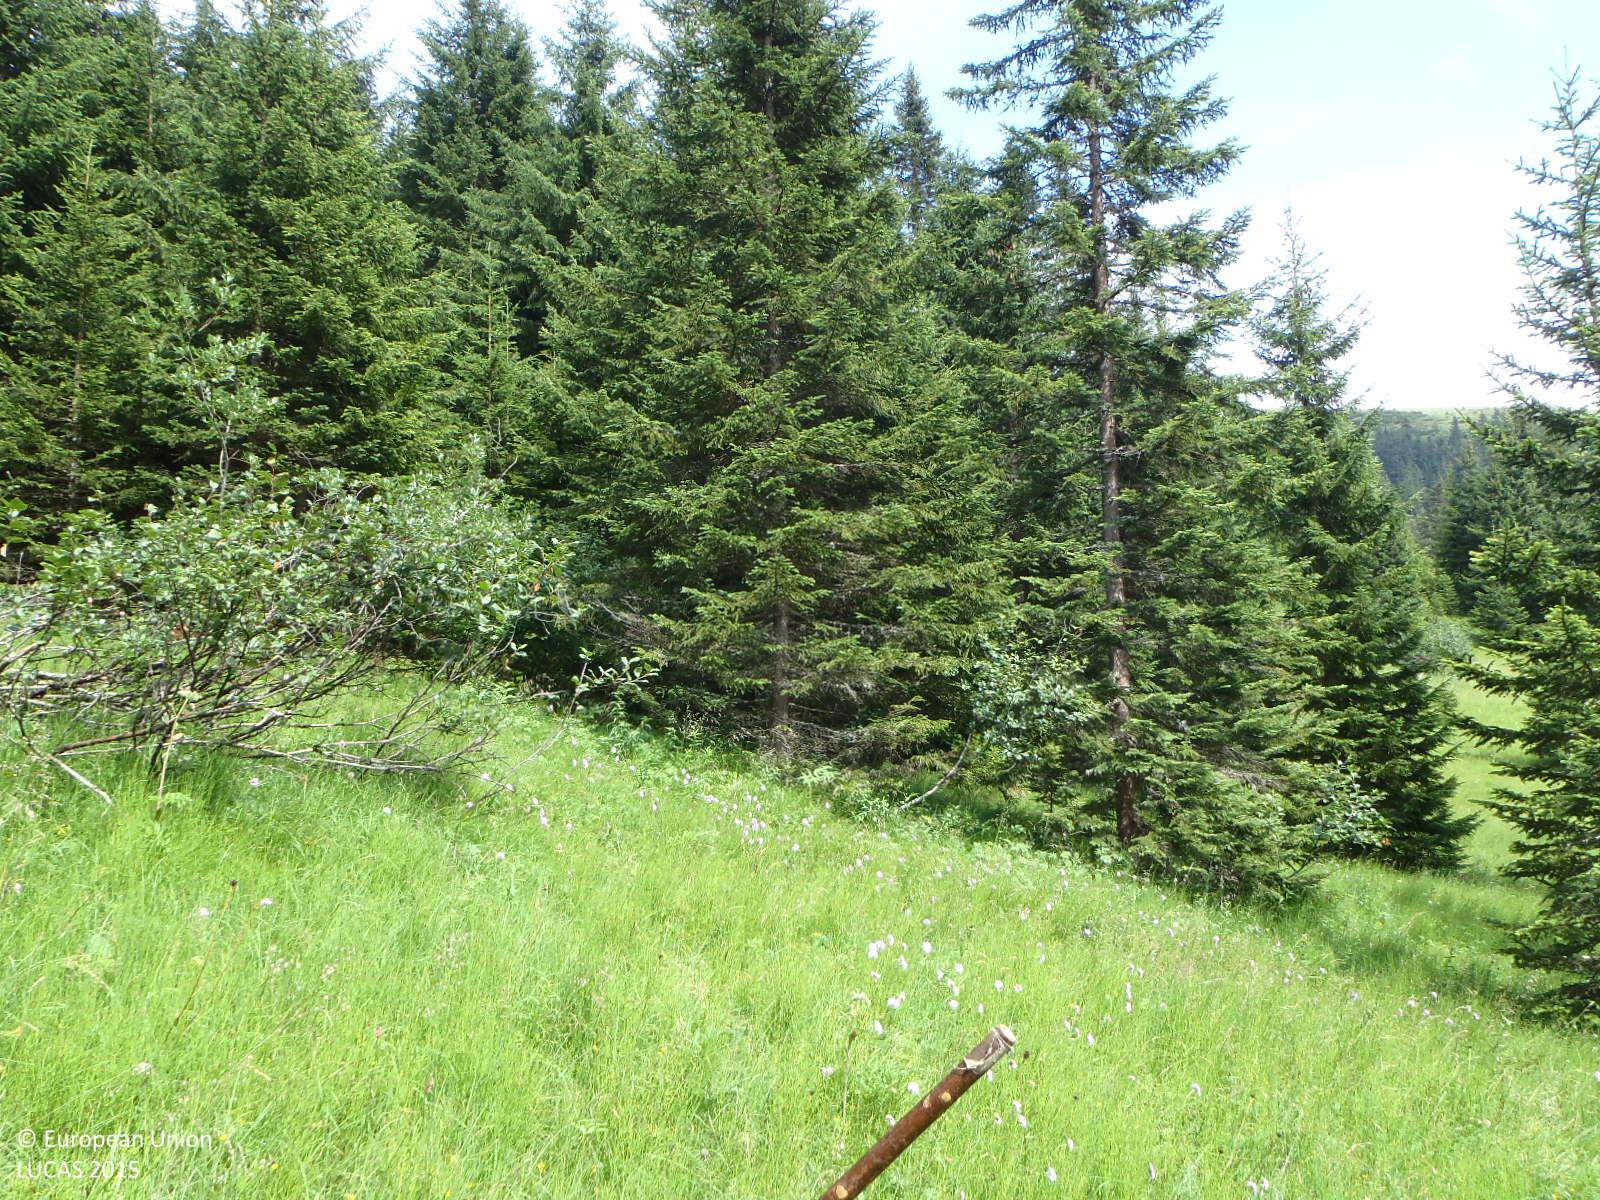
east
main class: Grassland
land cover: Grassland without tree/shrub cover
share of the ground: > 75 %
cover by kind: herbaceous plants 100 %
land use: Agriculture (excluding fallow land and kitchen gardens)
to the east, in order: Grassland without tree/shrub cover; Spruce dominated coniferous woodland; Fences; Grassland without tree/shrub cover; Fences; Grassland without tree/shrub cover; Artificial constructions in urban areas; Grassland without tree/shrub cover
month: July
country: AT
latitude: 47.1838
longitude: 11.7272
